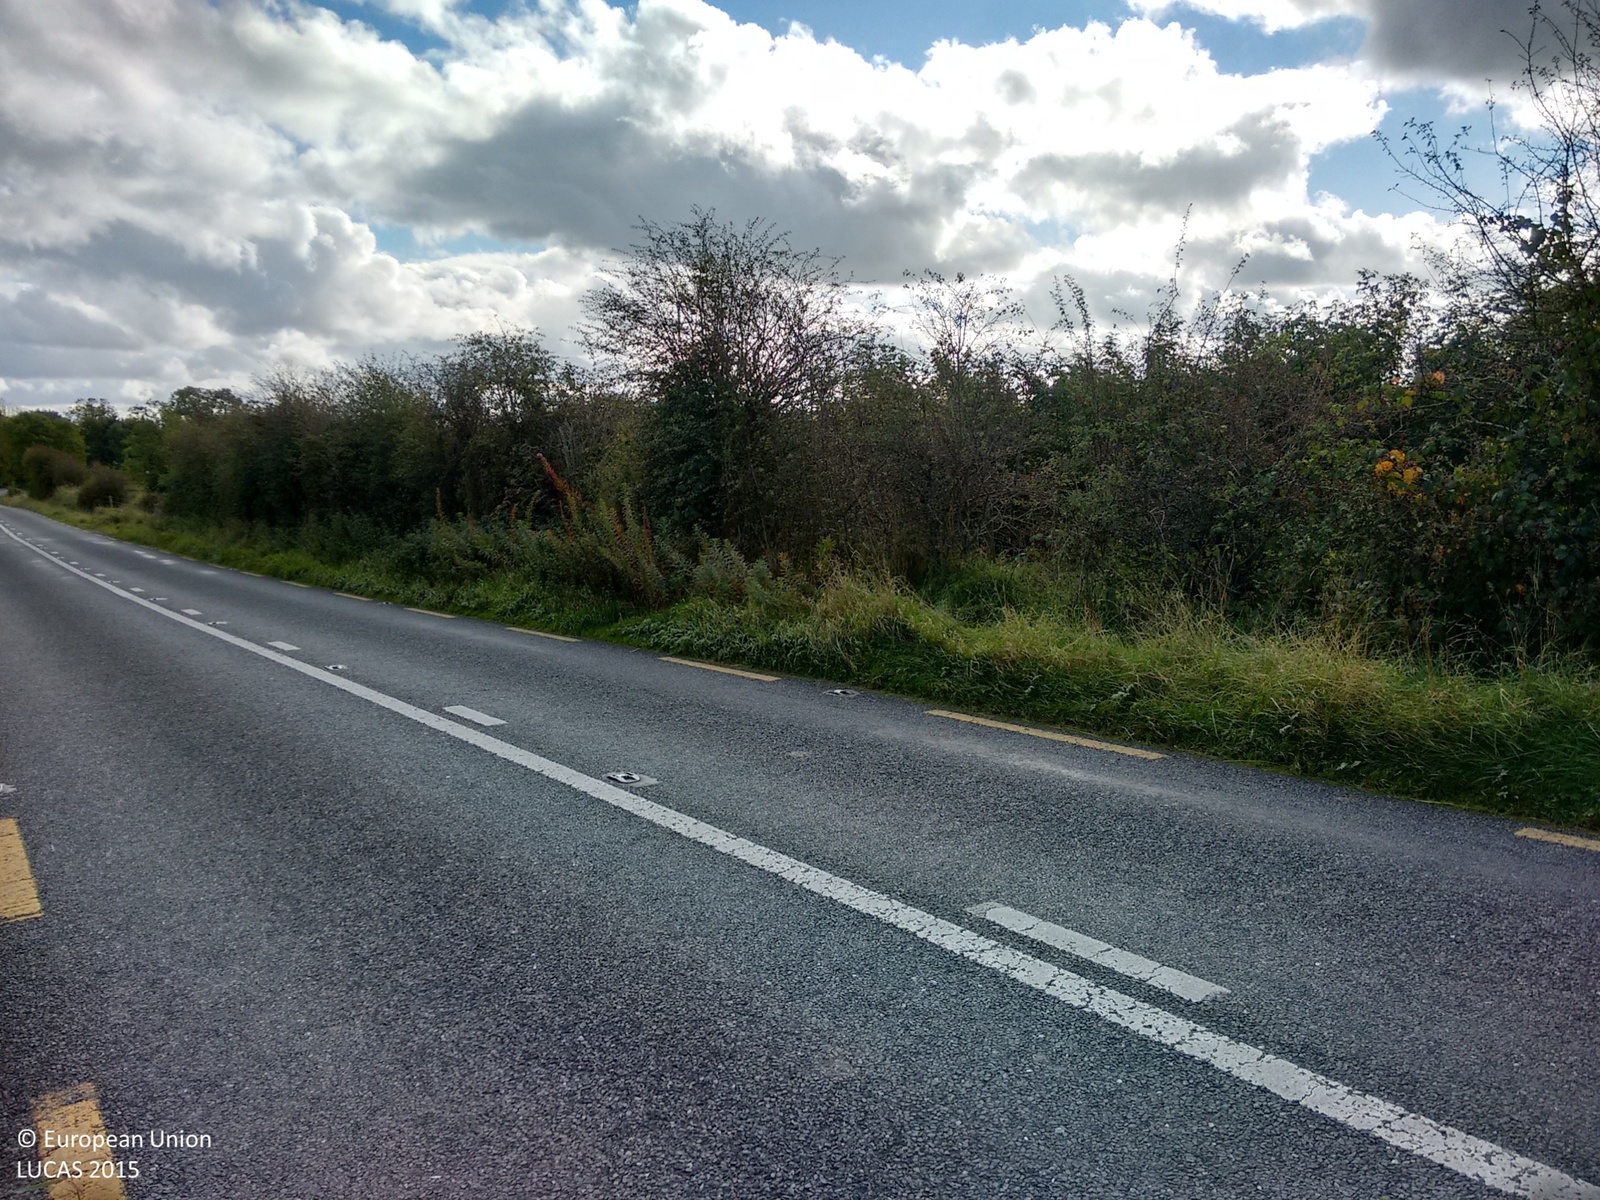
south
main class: Grassland
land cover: Grassland without tree/shrub cover
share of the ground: > 75 %
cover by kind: herbaceous plants 100 %
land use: Agriculture (excluding fallow land and kitchen gardens)
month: October
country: IE
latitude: 53.8654
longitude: -8.2331
